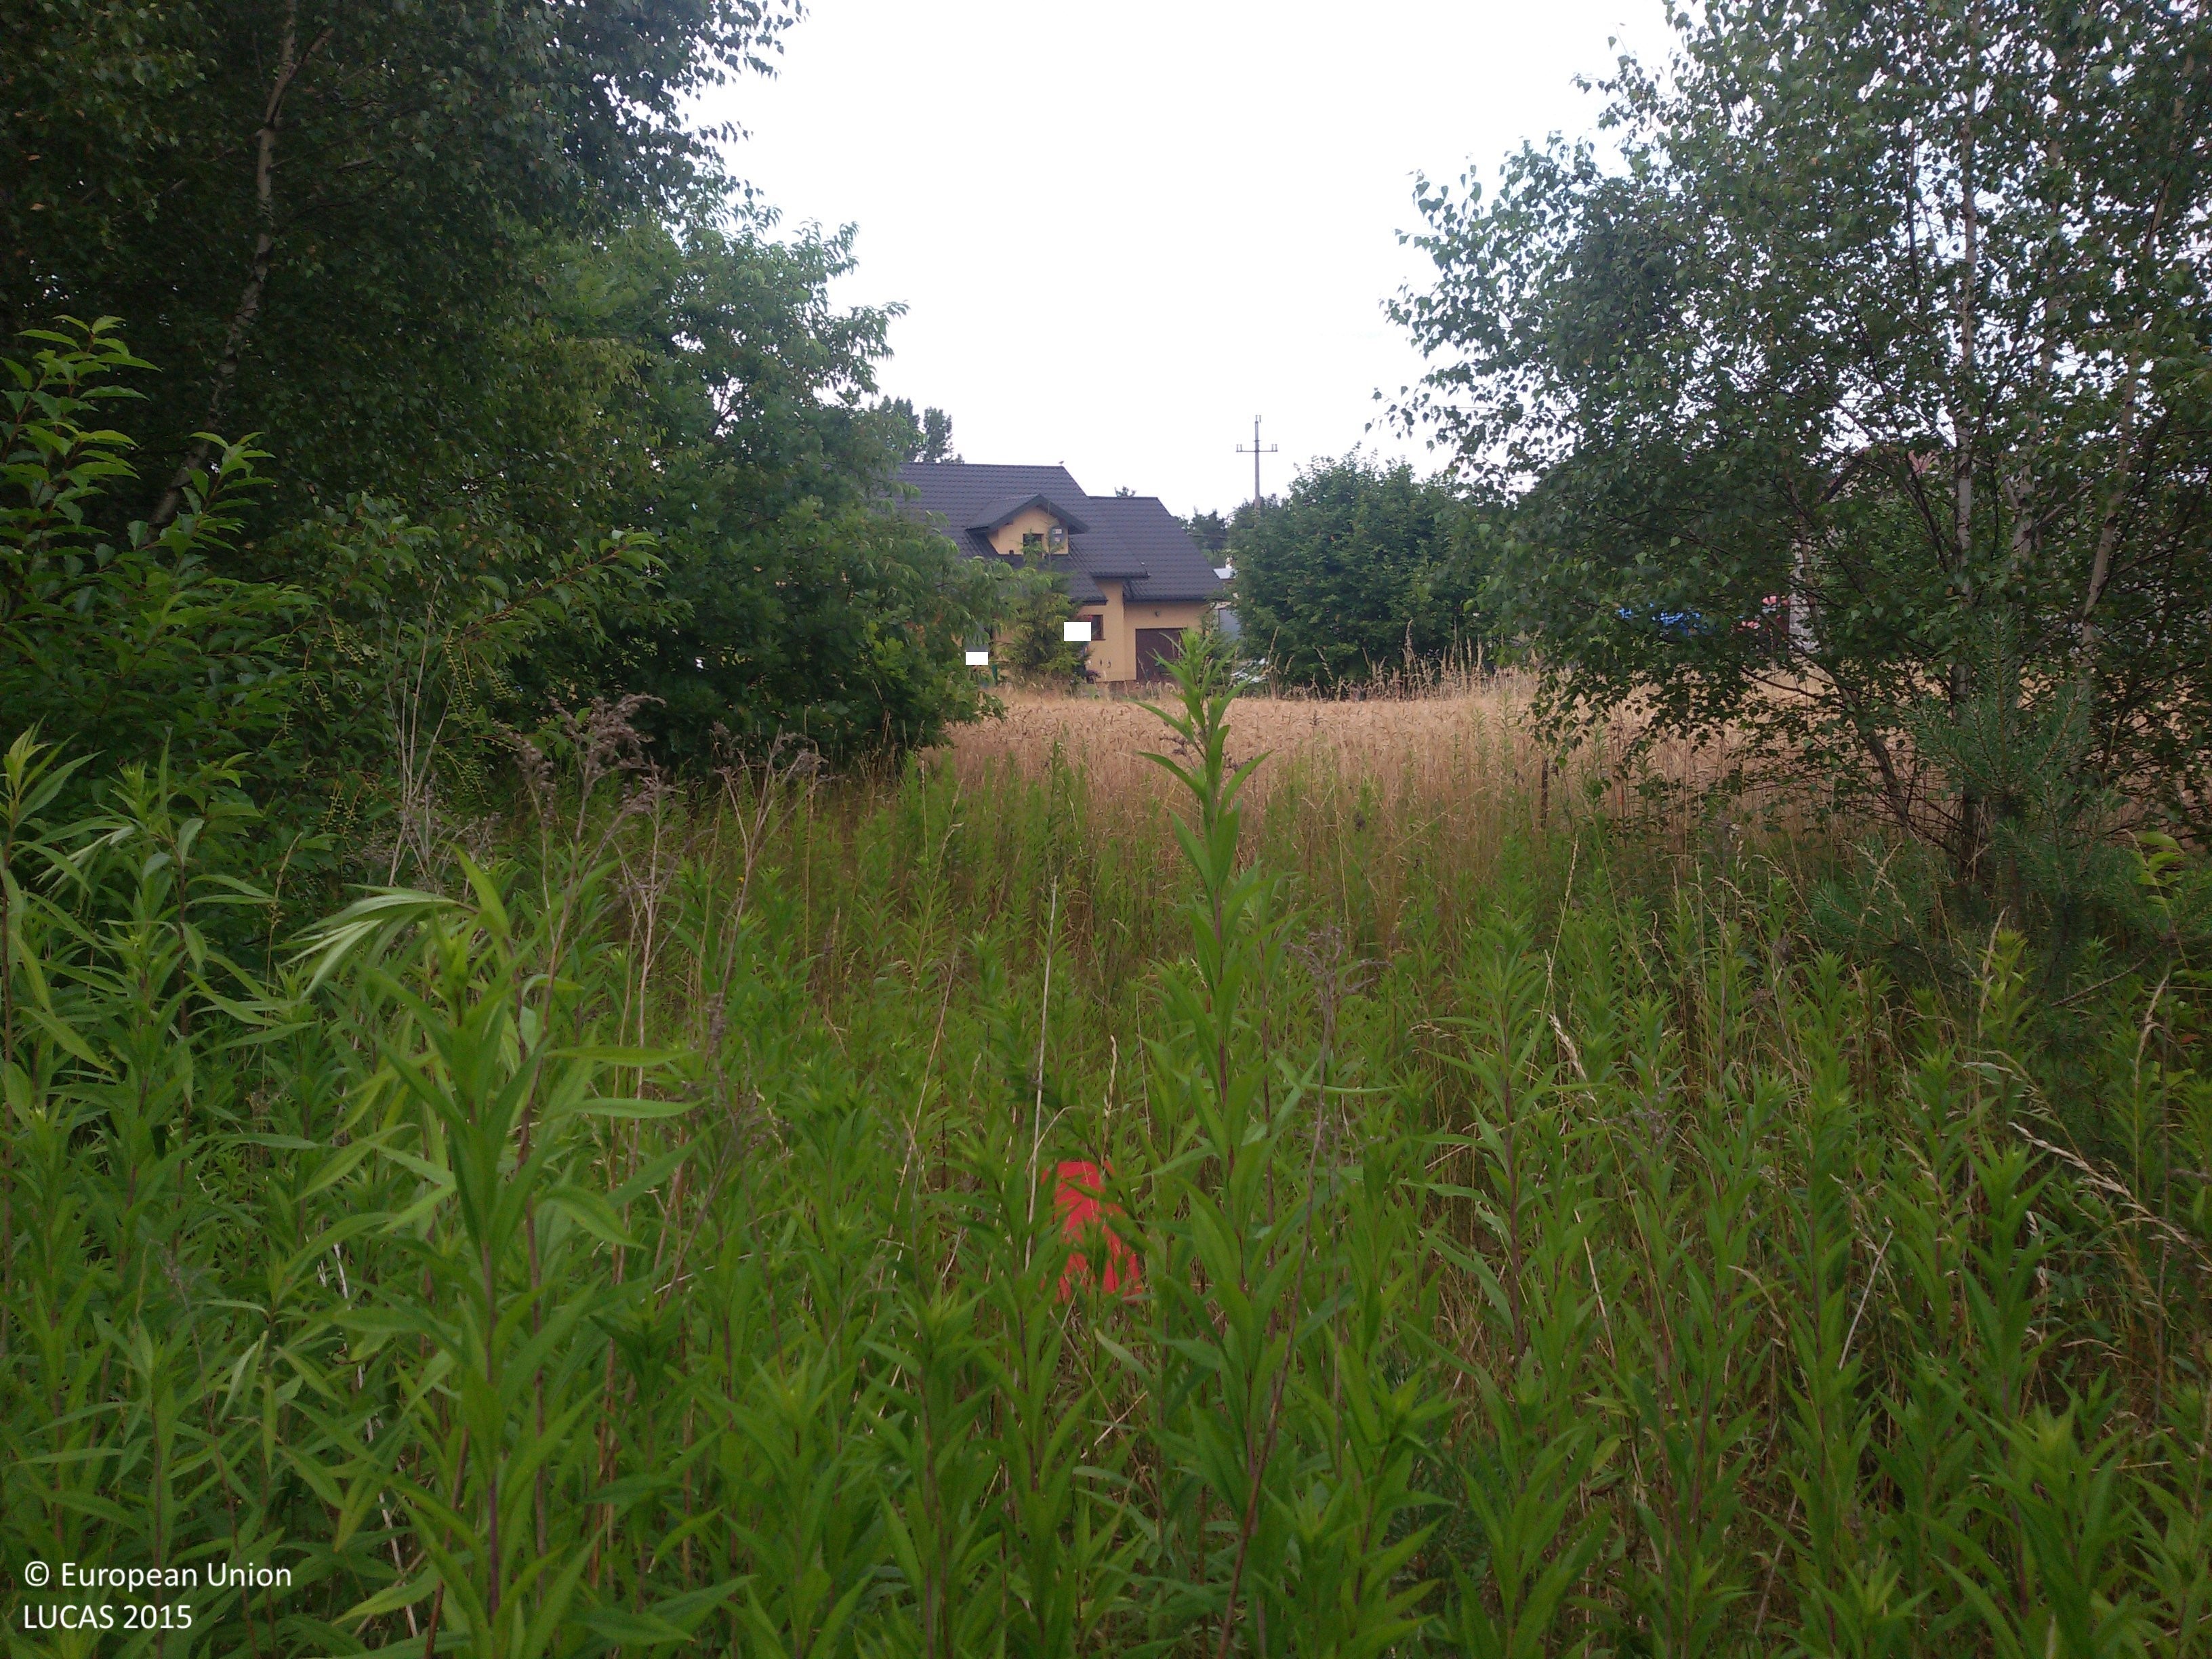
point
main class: Woodland
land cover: Broadleaved woodland
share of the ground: 10 - 25 %
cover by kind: herbaceous plants 85 %, broadleaved forest trees 15 %
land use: Semi-natural and natural areas not in use
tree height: > 5 m
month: July
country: PL
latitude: 52.7329
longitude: 19.1019
